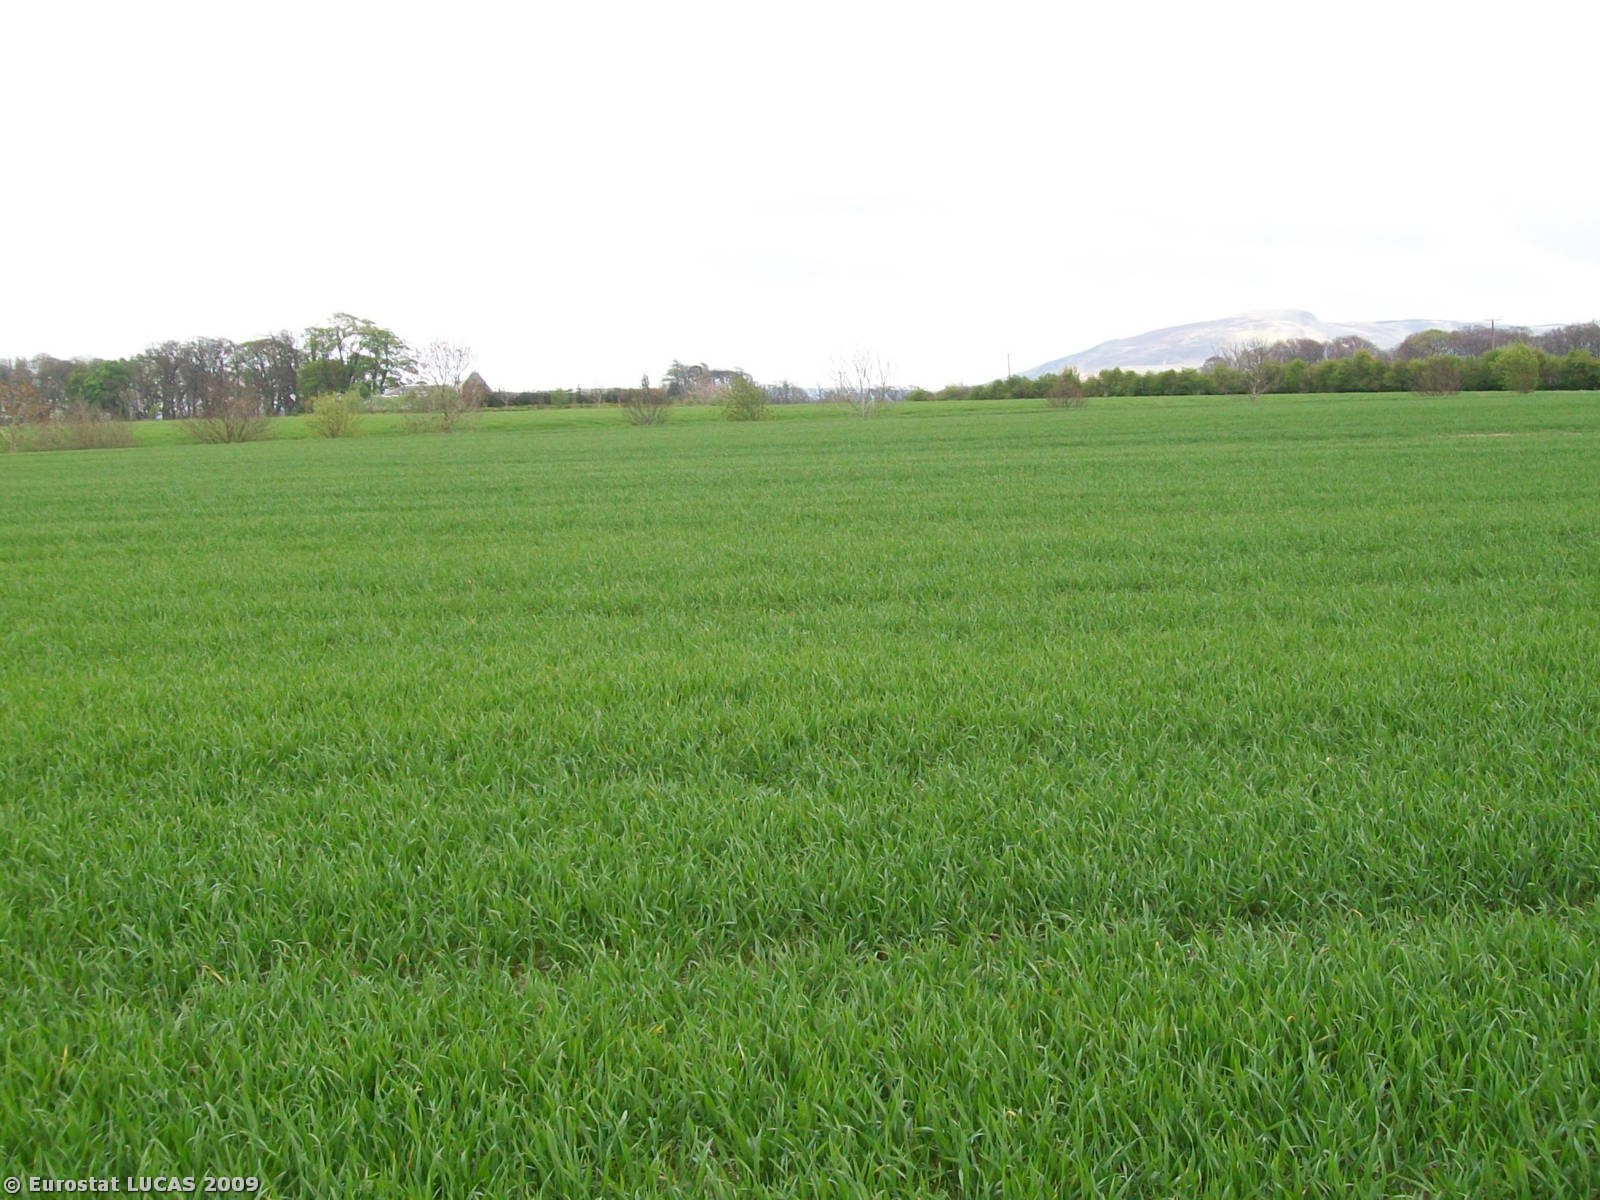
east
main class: Cropland
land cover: Common wheat
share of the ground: 50 - 75 %
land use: Agriculture (excluding fallow land and kitchen gardens)
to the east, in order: Common wheat; Grassland without tree/shrub cover; Fences; Rivers and streams; Shrubland with sparse tree cover; Fences; Common wheat
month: April
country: GB
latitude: 56.3029
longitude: -3.7371
